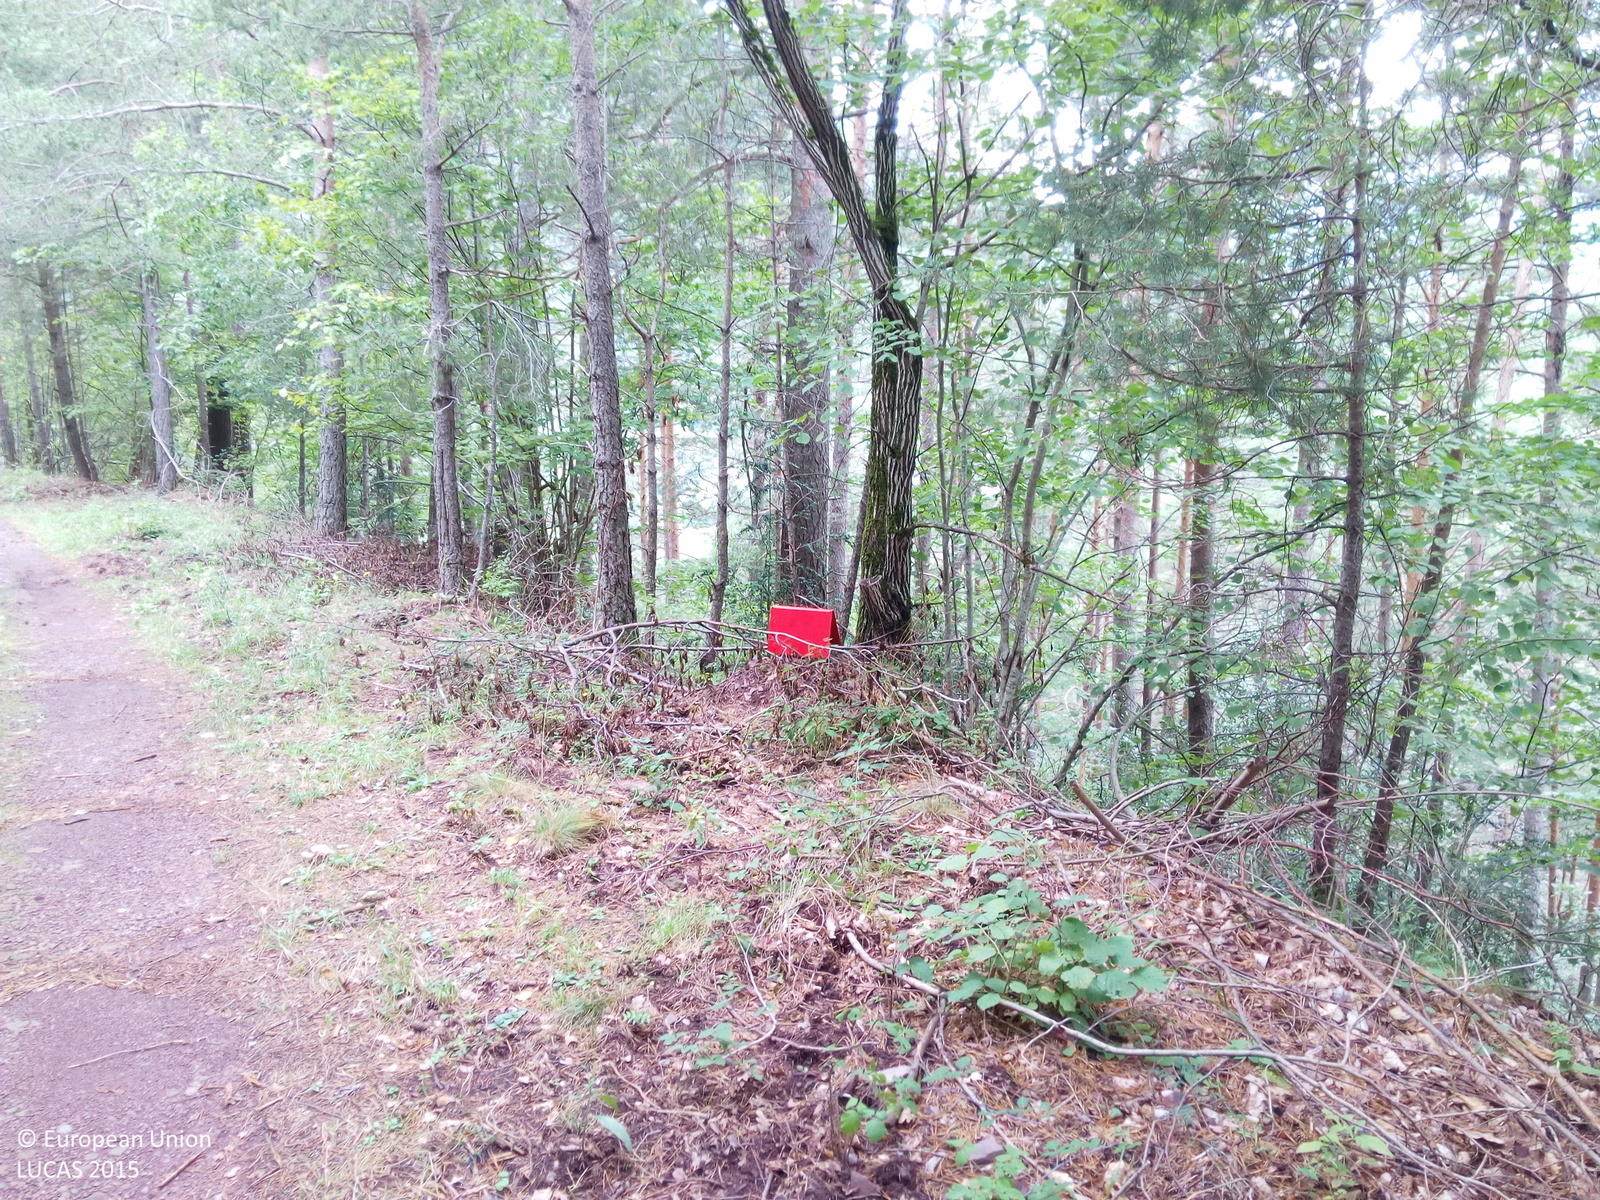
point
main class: Woodland
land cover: Pine dominated mixed woodland
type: alpine coniferous forest
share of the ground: > 75 %
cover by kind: coniferous forest trees 55 %, broadleaved forest trees 45 %
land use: Semi-natural and natural areas not in use
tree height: > 5 m
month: September
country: ES
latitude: 42.6176
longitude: 0.2370
